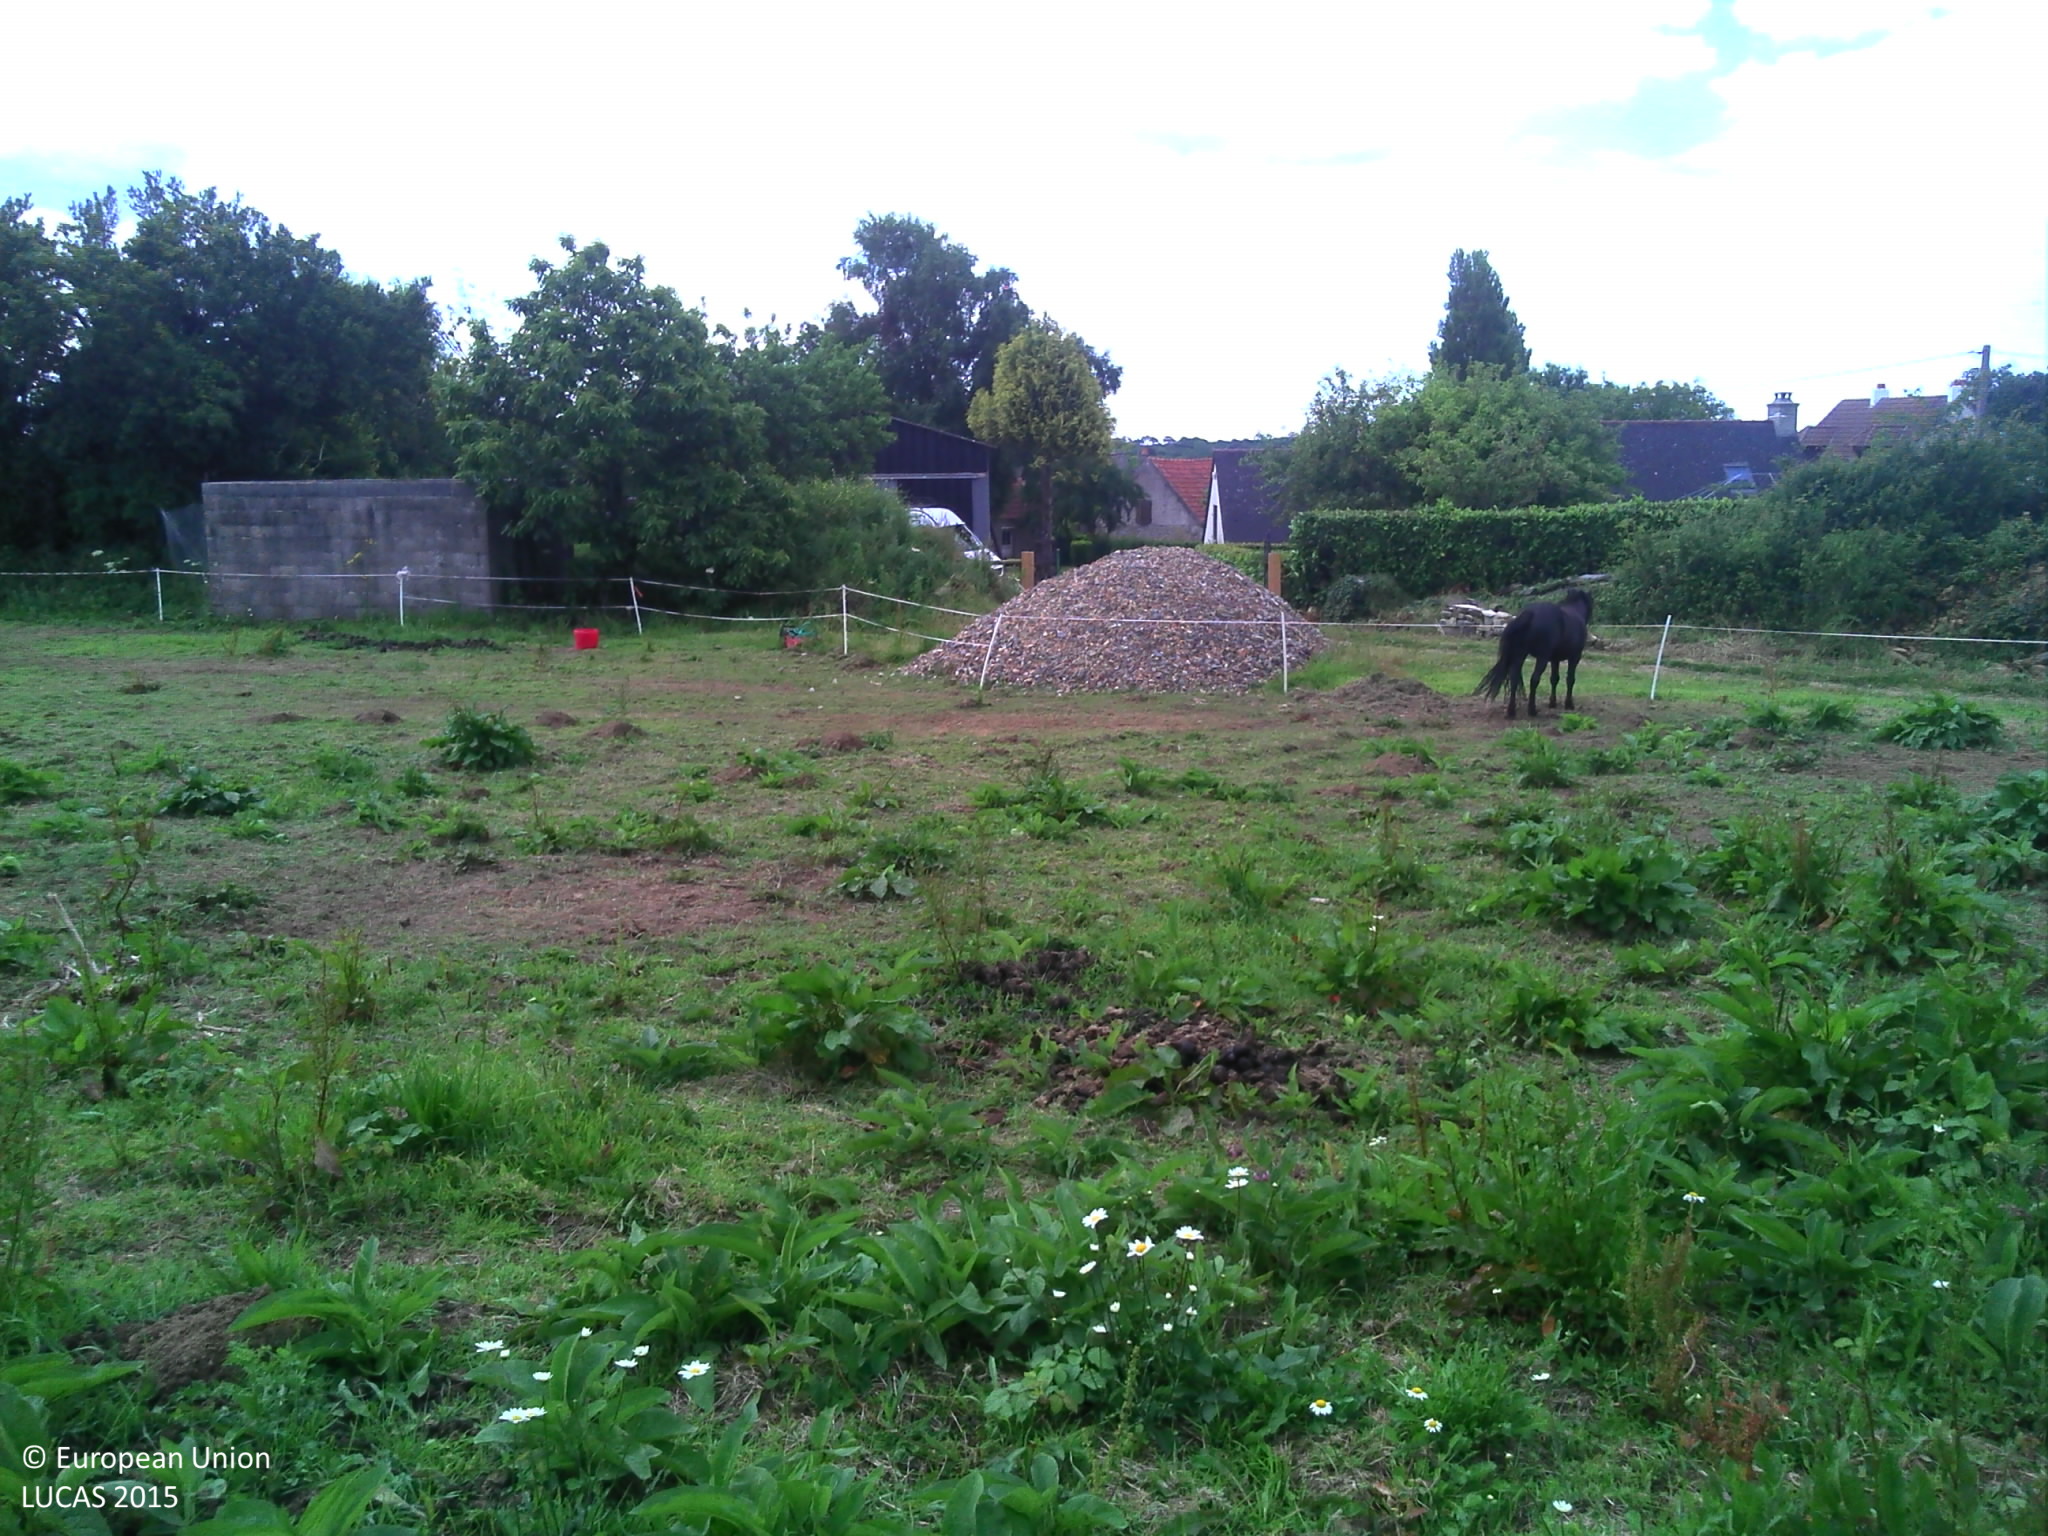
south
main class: Grassland
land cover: Grassland without tree/shrub cover
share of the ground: > 75 %
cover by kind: herbaceous plants 100 %
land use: Agriculture (excluding fallow land and kitchen gardens)
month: June
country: FR
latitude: 49.3656
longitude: -1.6597
